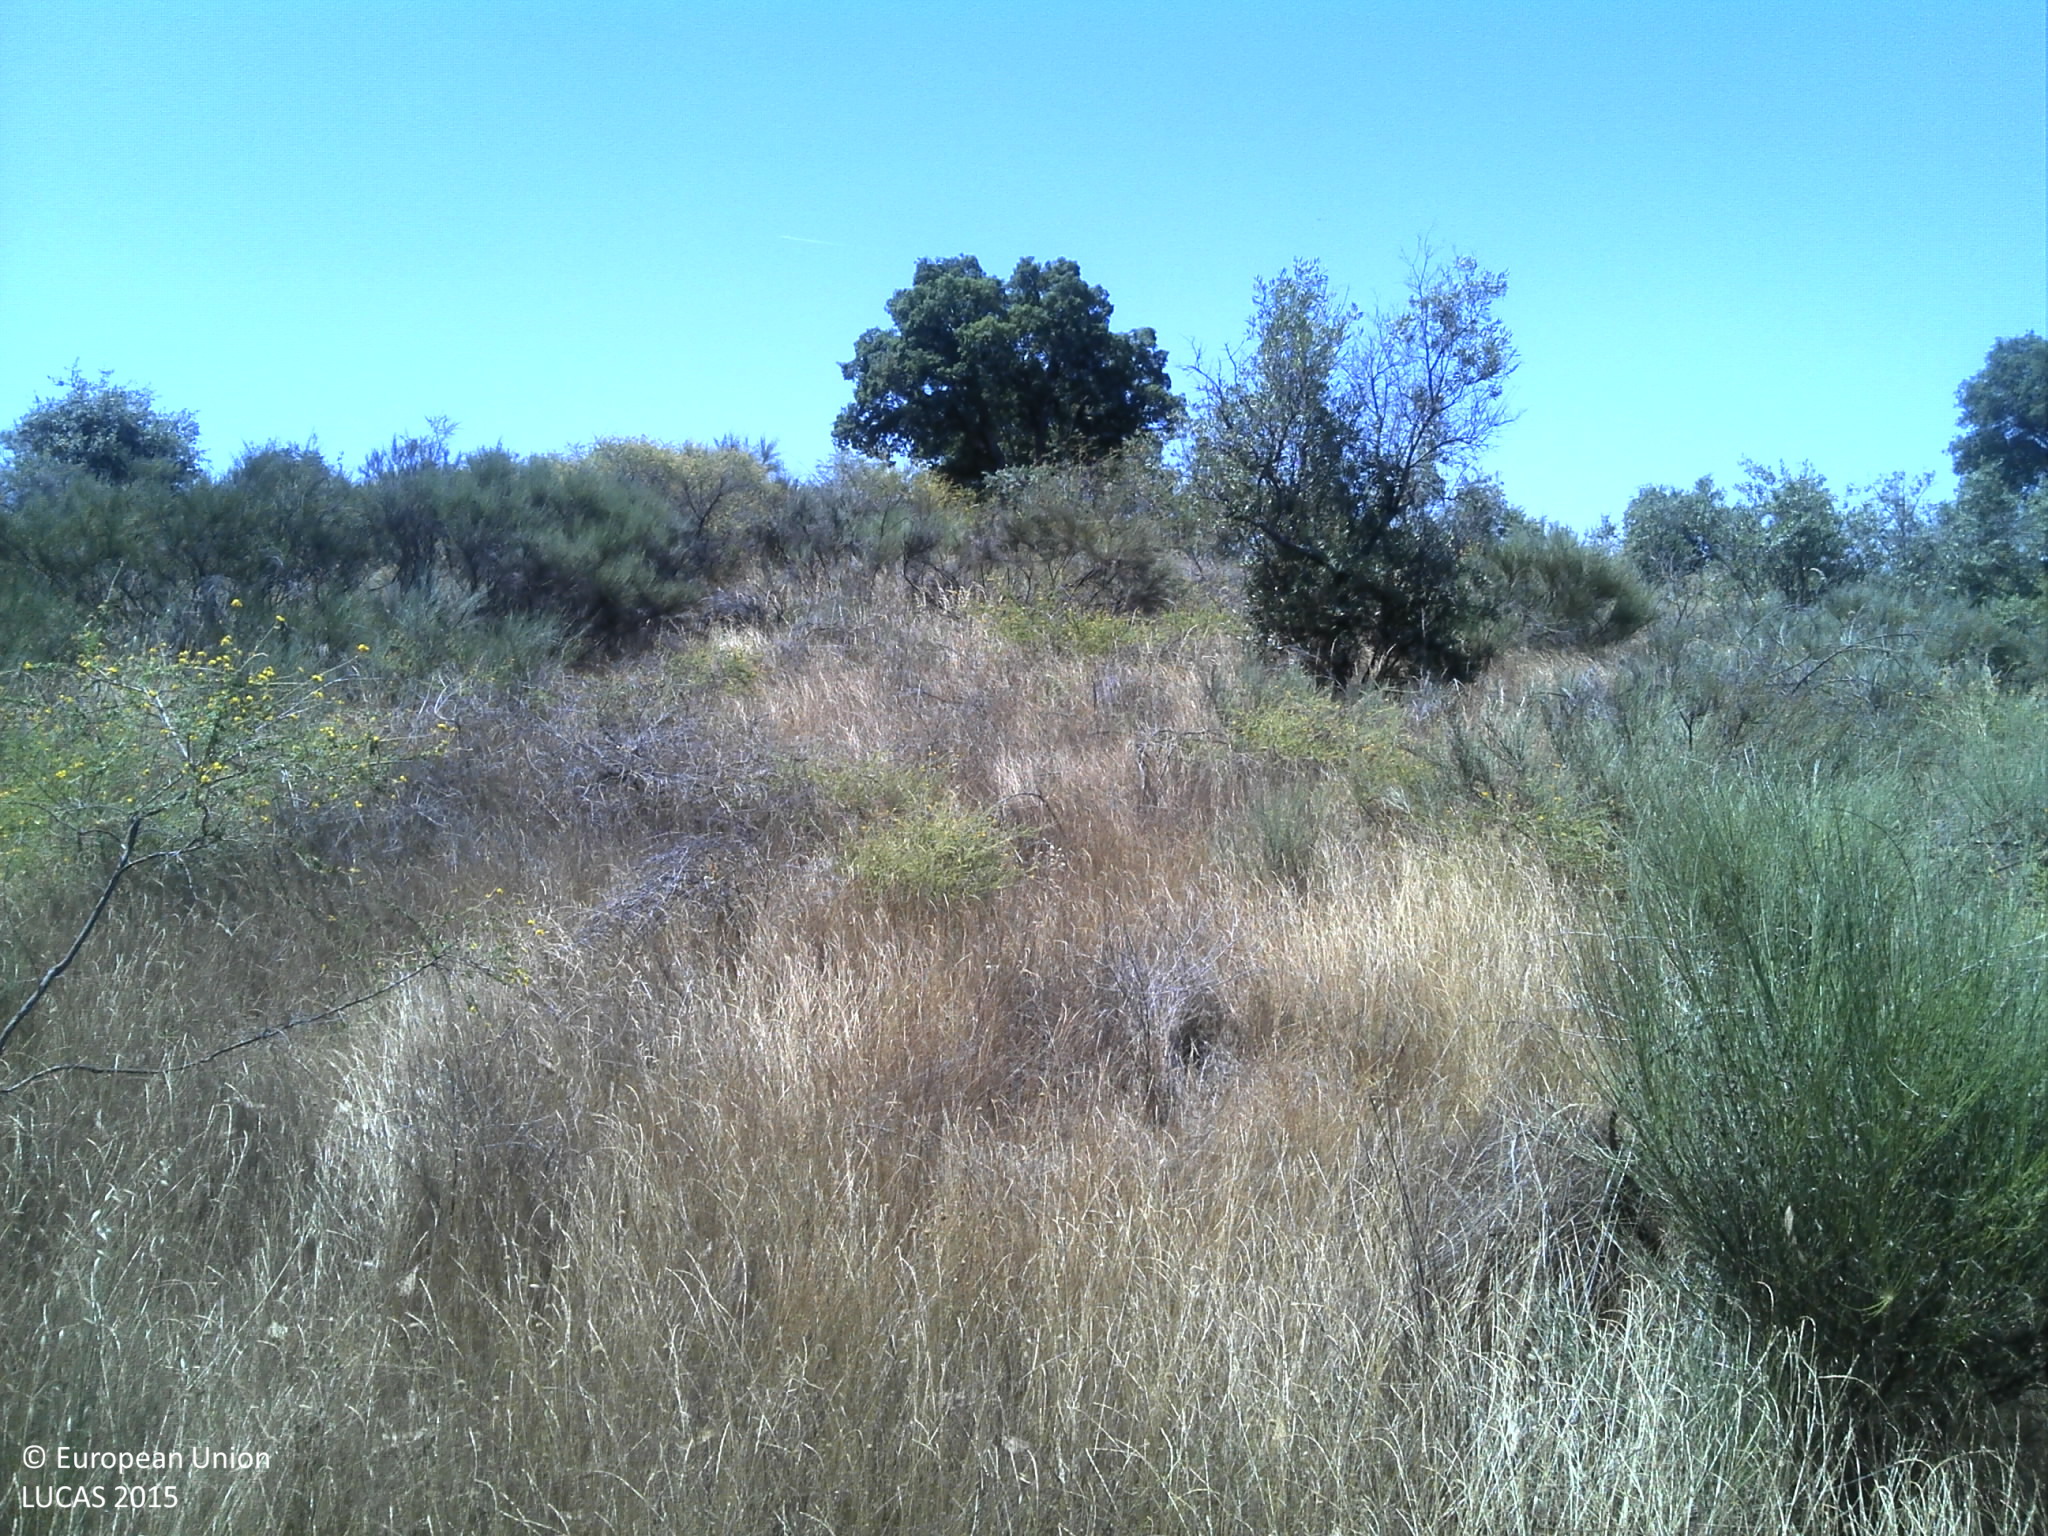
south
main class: Shrubland
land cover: Shrubland with sparse tree cover
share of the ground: 25 - 50 %
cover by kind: shrubs 40 %, herbaceous plants 40 %, unconsolidated bare surface 10 %, broadleaved forest trees 5 %
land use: Abandoned areas
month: June
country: PT
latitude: 40.0035
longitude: -7.3294
